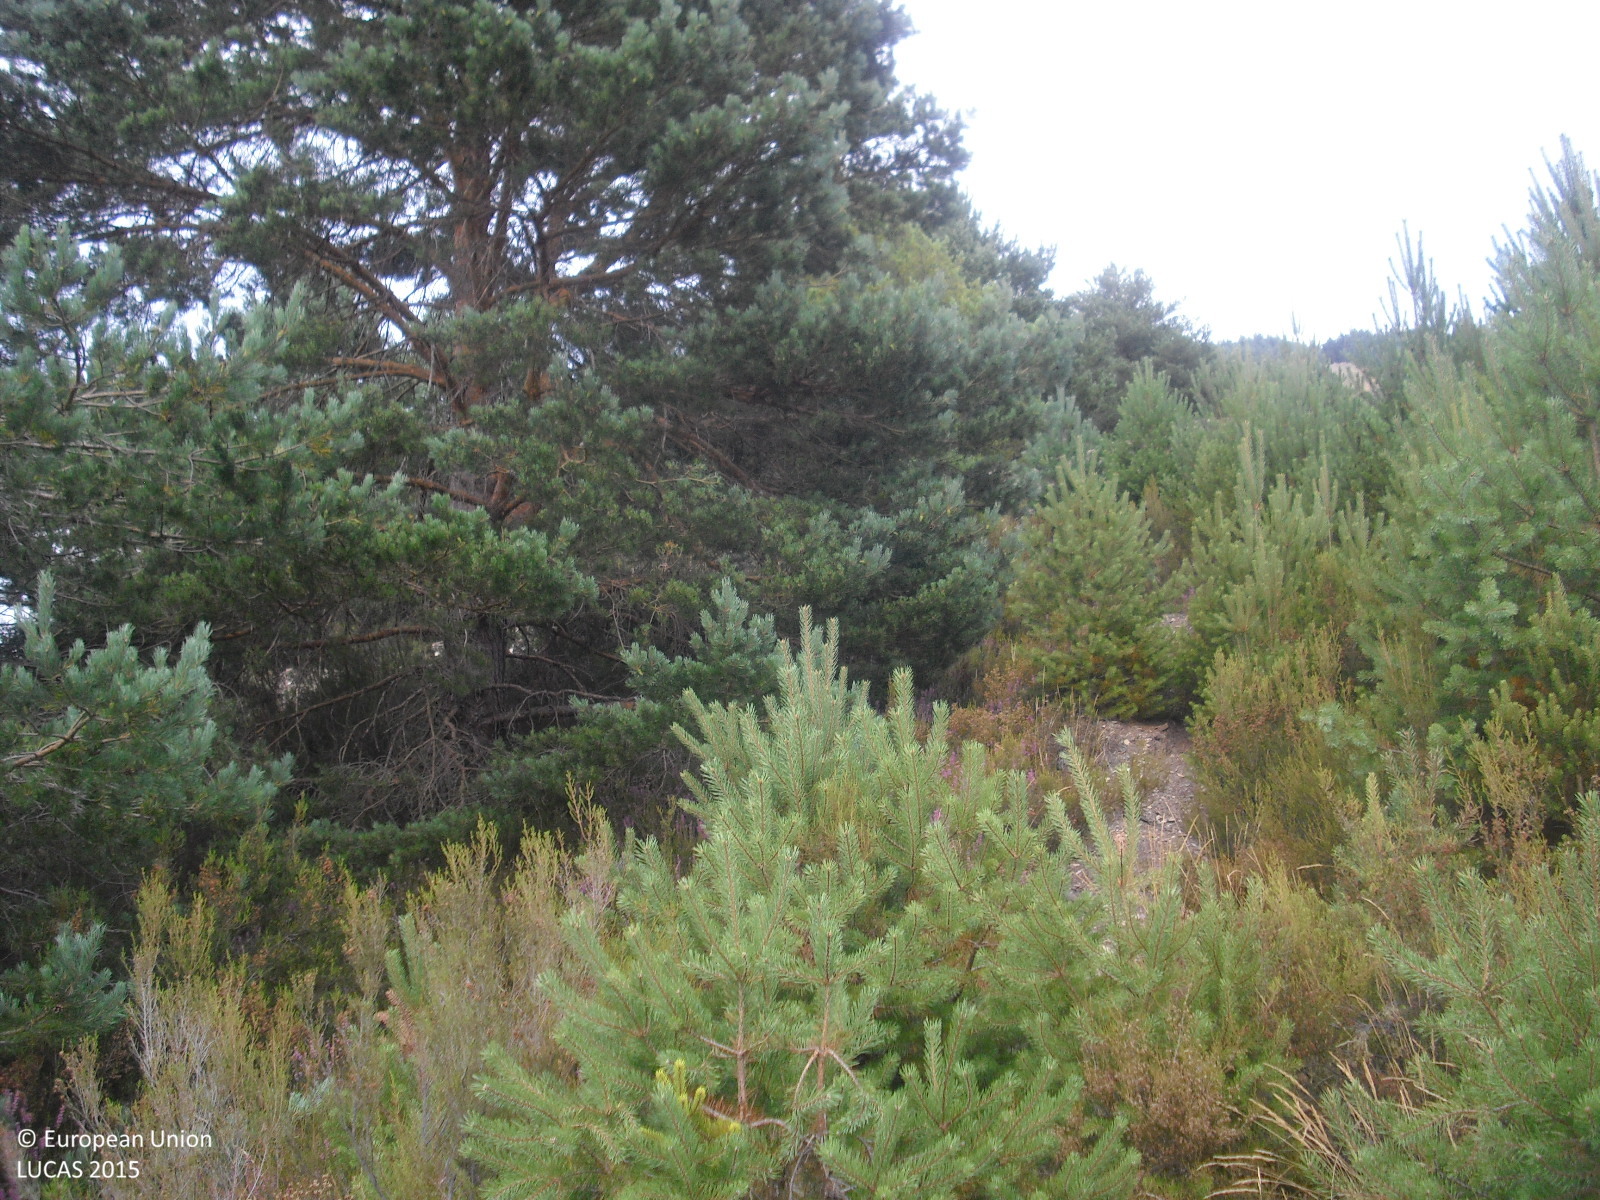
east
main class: Woodland
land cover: Pine dominated mixed woodland
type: hemiboreal forest and nemoral coniferous forest and mixed broadleaved-coniferous forest
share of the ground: 25 - 50 %
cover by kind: broadleaved forest trees 50 %, coniferous forest trees 30 %, consolidated bare surface 20 %
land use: Semi-natural and natural areas not in use
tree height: > 5 m
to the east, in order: Pine dominated mixed woodland; Rock outcrops; Pine dominated mixed woodland
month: July
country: ES
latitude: 42.5435
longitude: -7.2446
